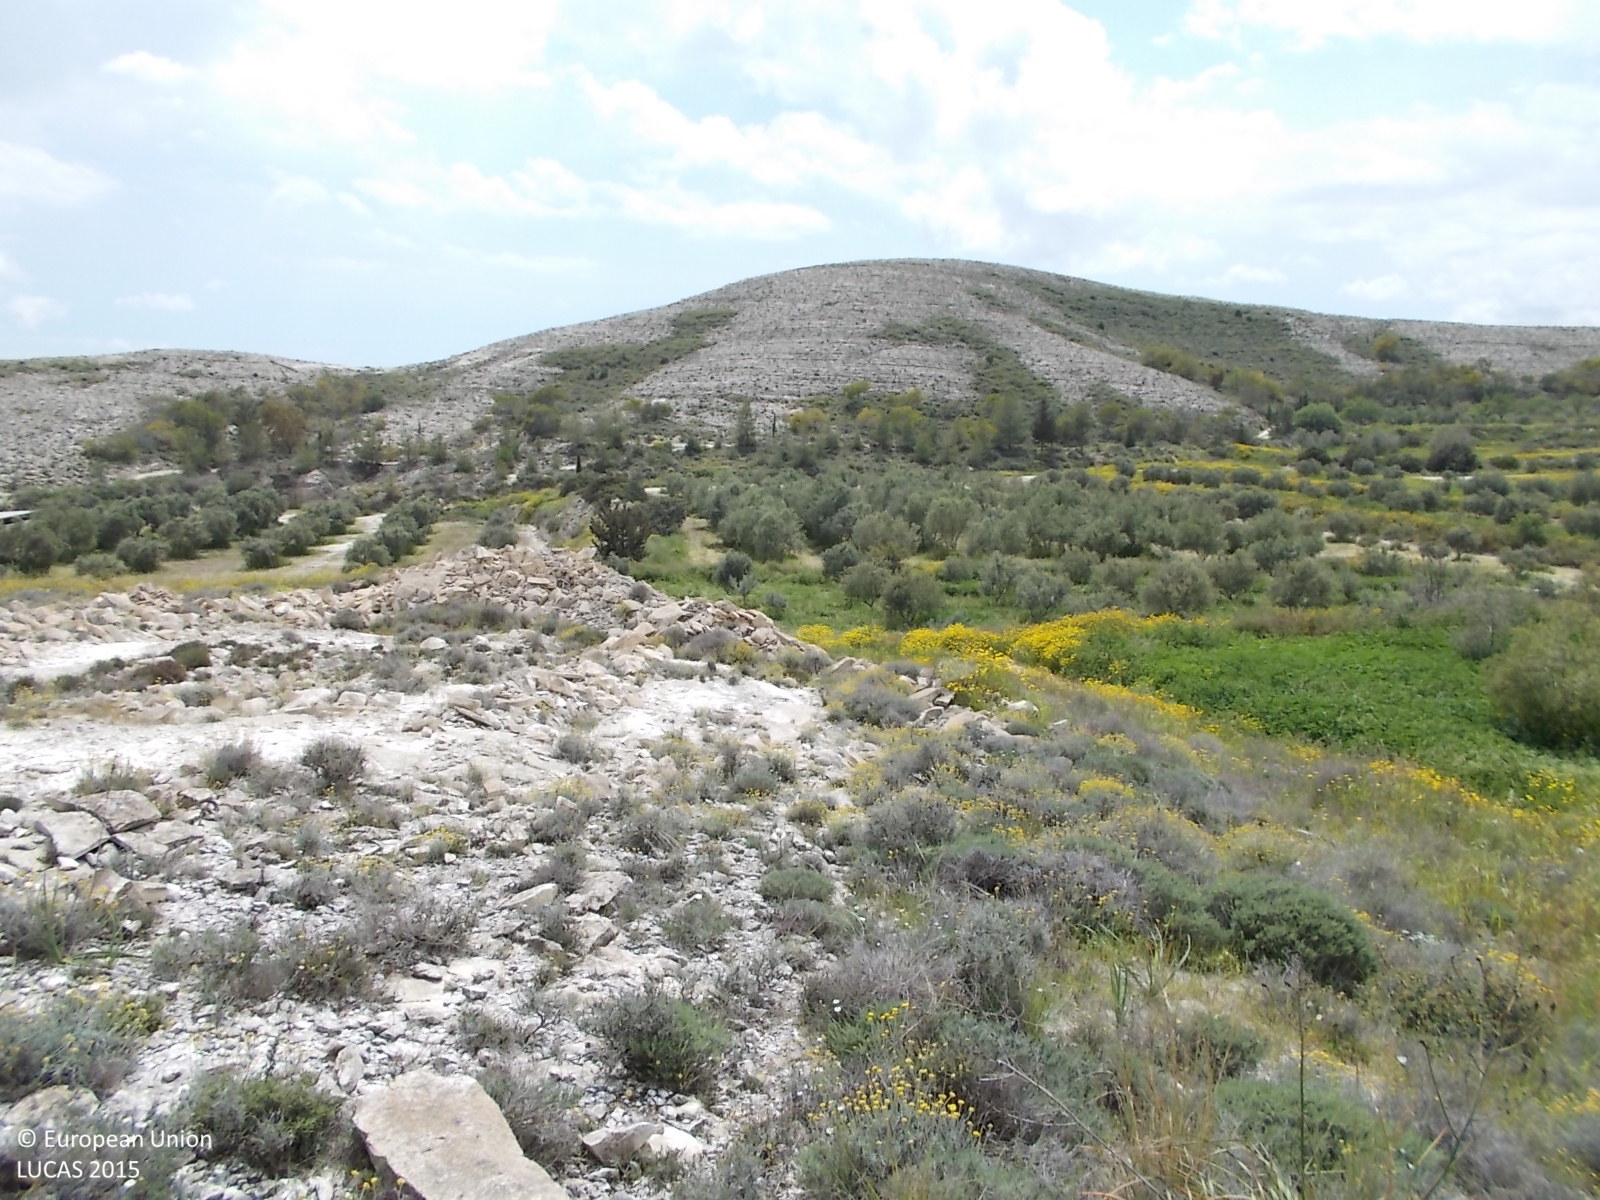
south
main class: Shrubland
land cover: Shrubland without tree cover
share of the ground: 25 - 50 %
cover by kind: shrubs 50 %, unconsolidated bare surface 50 %
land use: Semi-natural and natural areas not in use
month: April
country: CY
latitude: 34.9861
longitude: 33.5629
